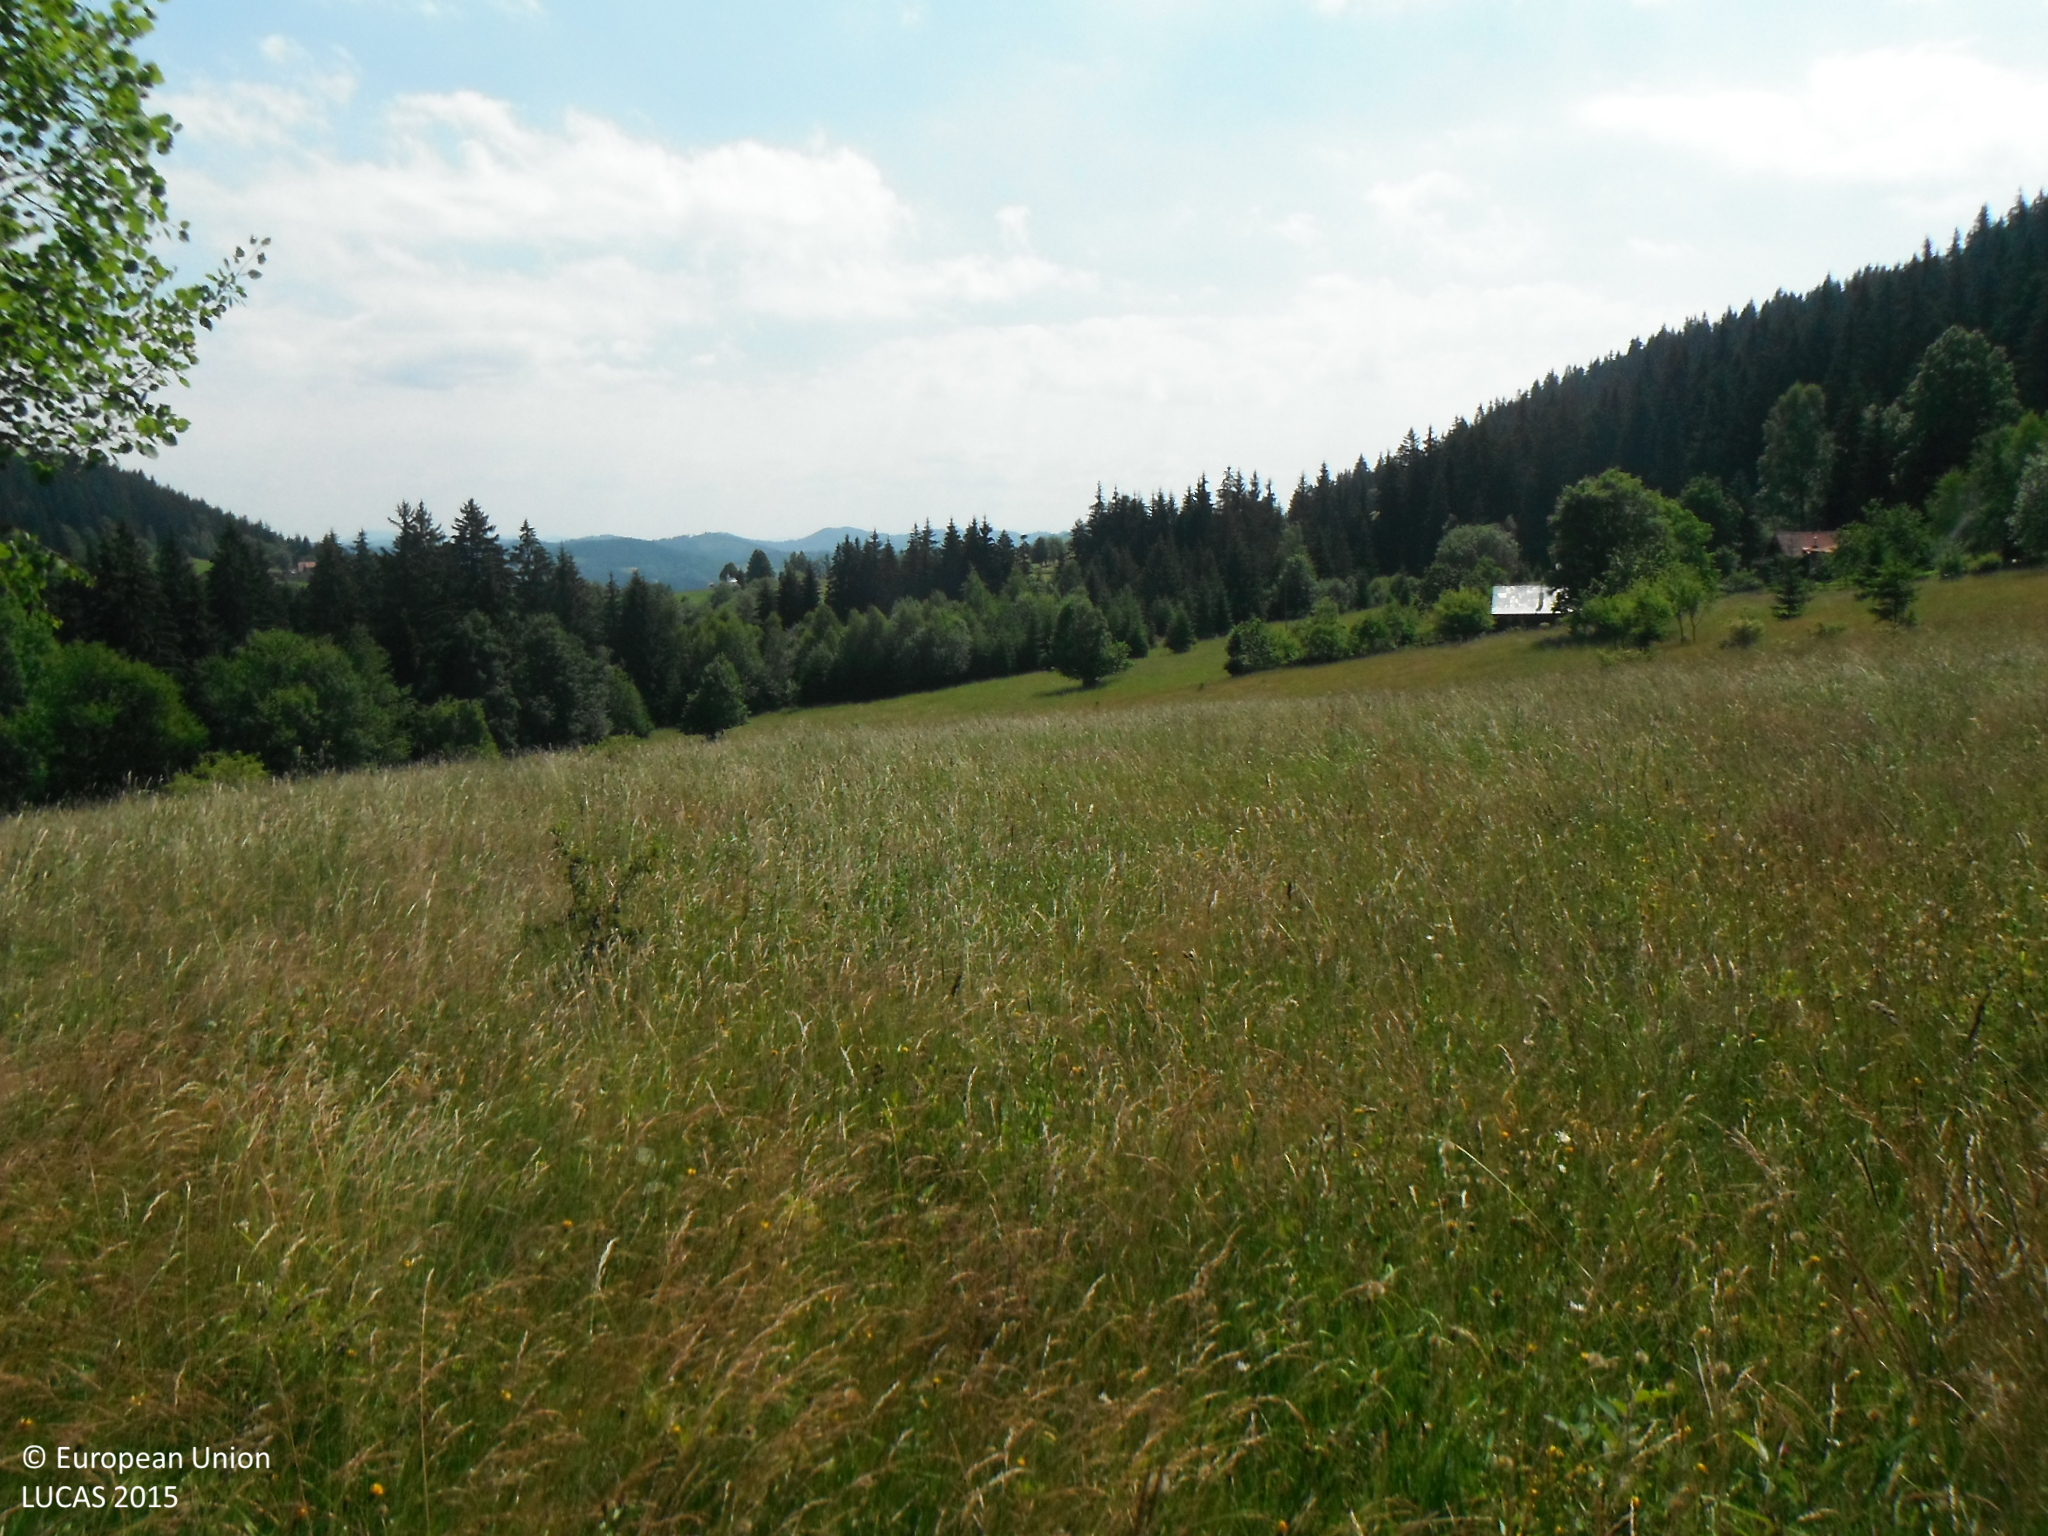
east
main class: Grassland
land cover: Grassland without tree/shrub cover
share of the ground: > 75 %
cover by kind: herbaceous plants 95 %, shrubs 5 %
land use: Agriculture (excluding fallow land and kitchen gardens)
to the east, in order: Grassland without tree/shrub cover; Spruce dominated mixed woodland
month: July
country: SK
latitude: 49.3412
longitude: 18.5103
